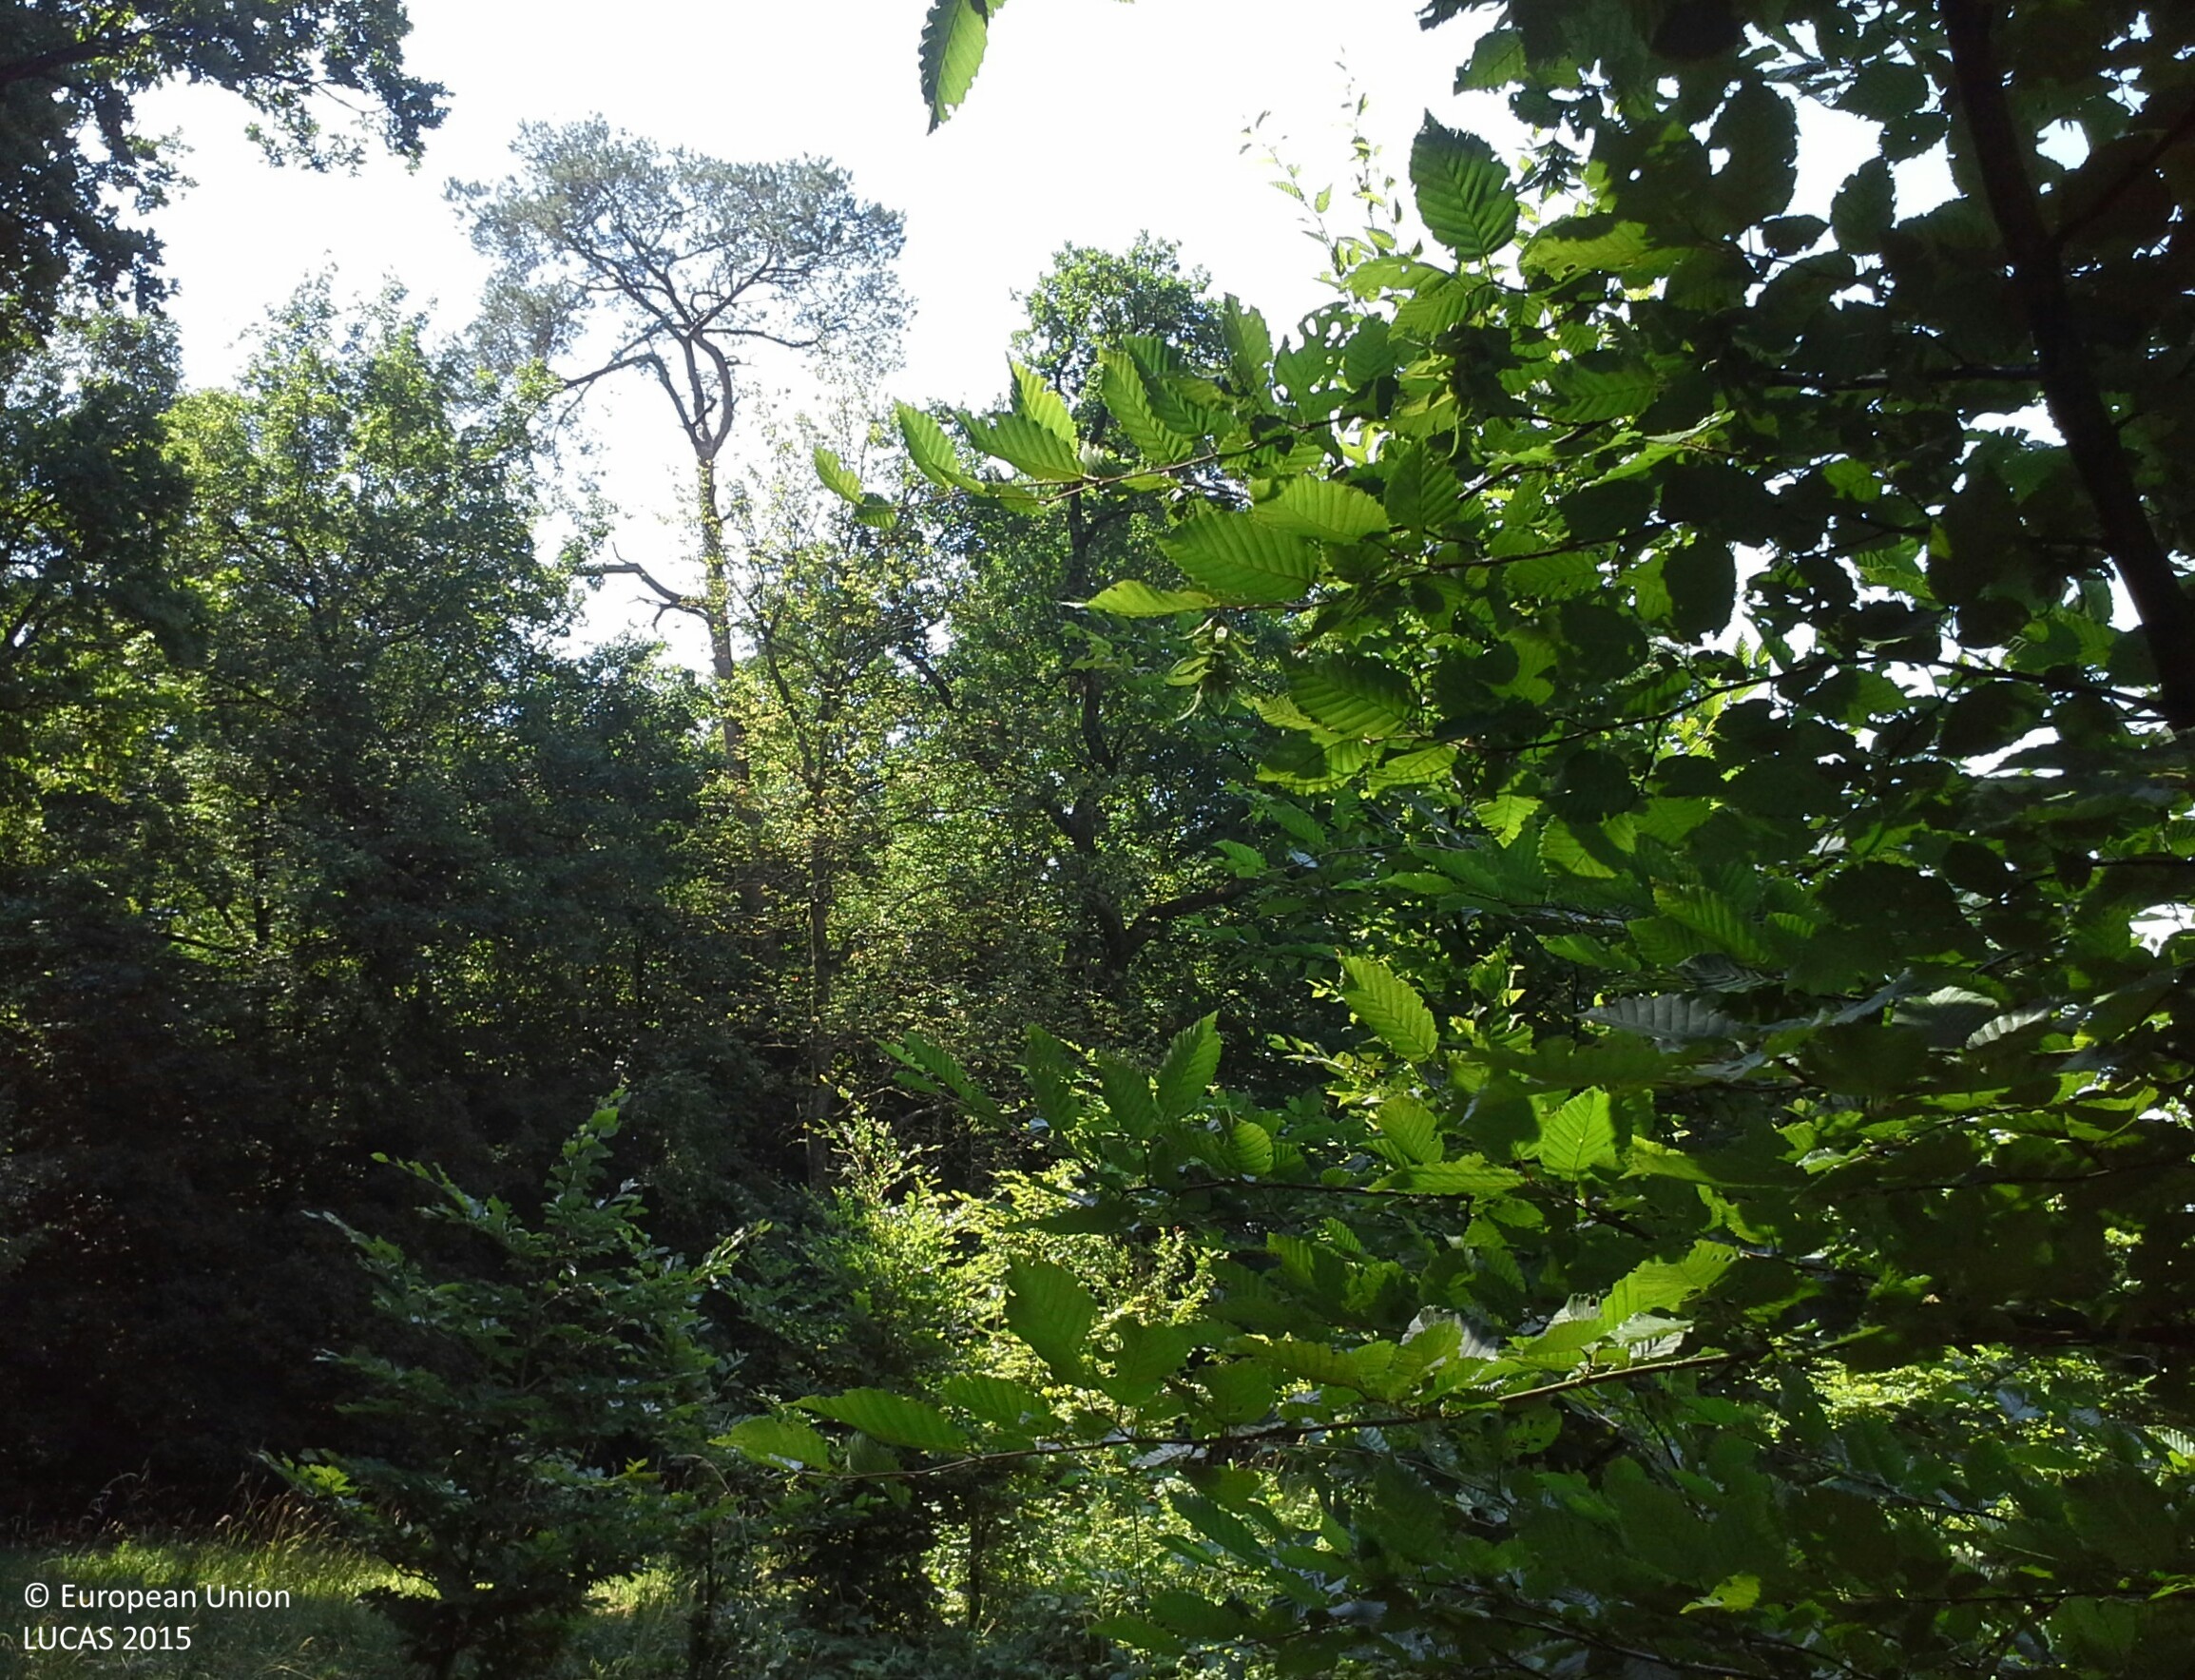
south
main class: Woodland
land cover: Broadleaved woodland
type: mesophytic deciduous forest
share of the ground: > 75 %
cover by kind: broadleaved forest trees 70 %, shrubs 15 %, herbaceous plants 15 %
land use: Forestry
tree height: < 5 m
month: July
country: AT
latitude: 48.0989
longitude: 14.8483
